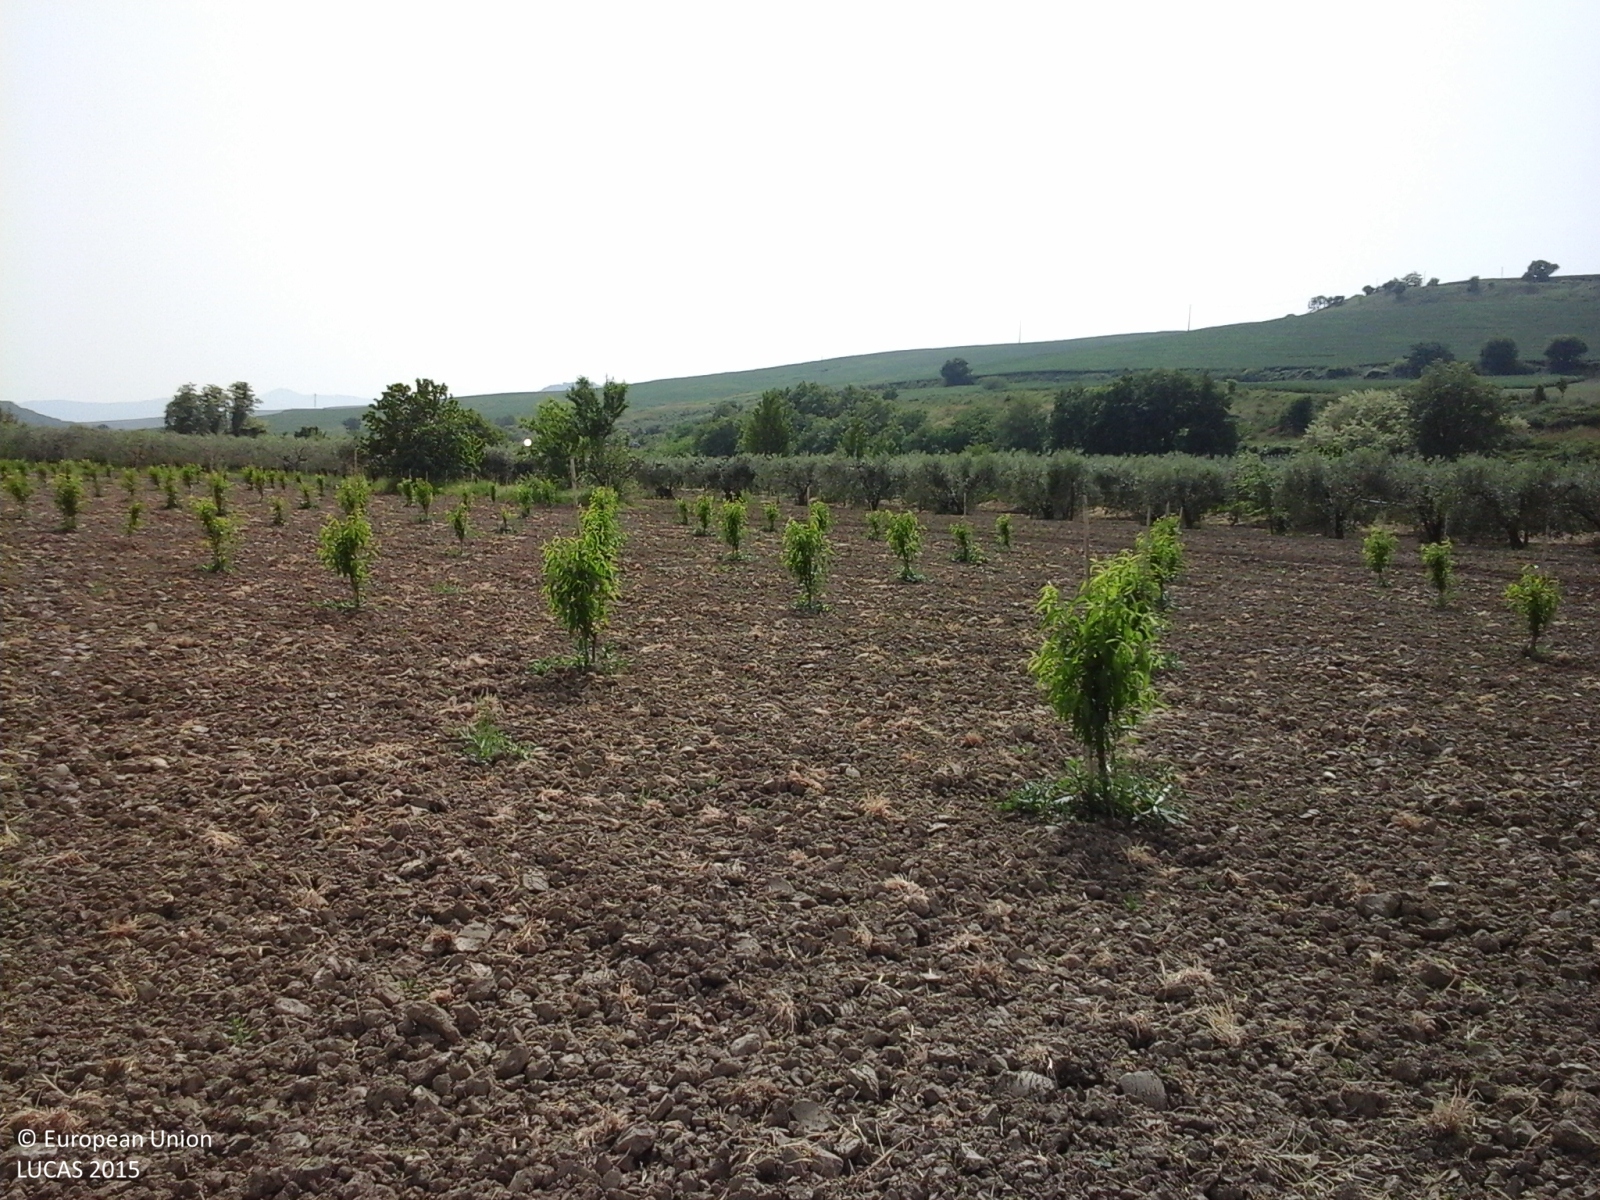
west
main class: Cropland
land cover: Other fruit trees and berries
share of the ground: 25 - 50 %
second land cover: Other bare soil
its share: > 75 %
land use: Agriculture (excluding fallow land and kitchen gardens)
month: May
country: IT
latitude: 42.0188
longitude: 14.7313
